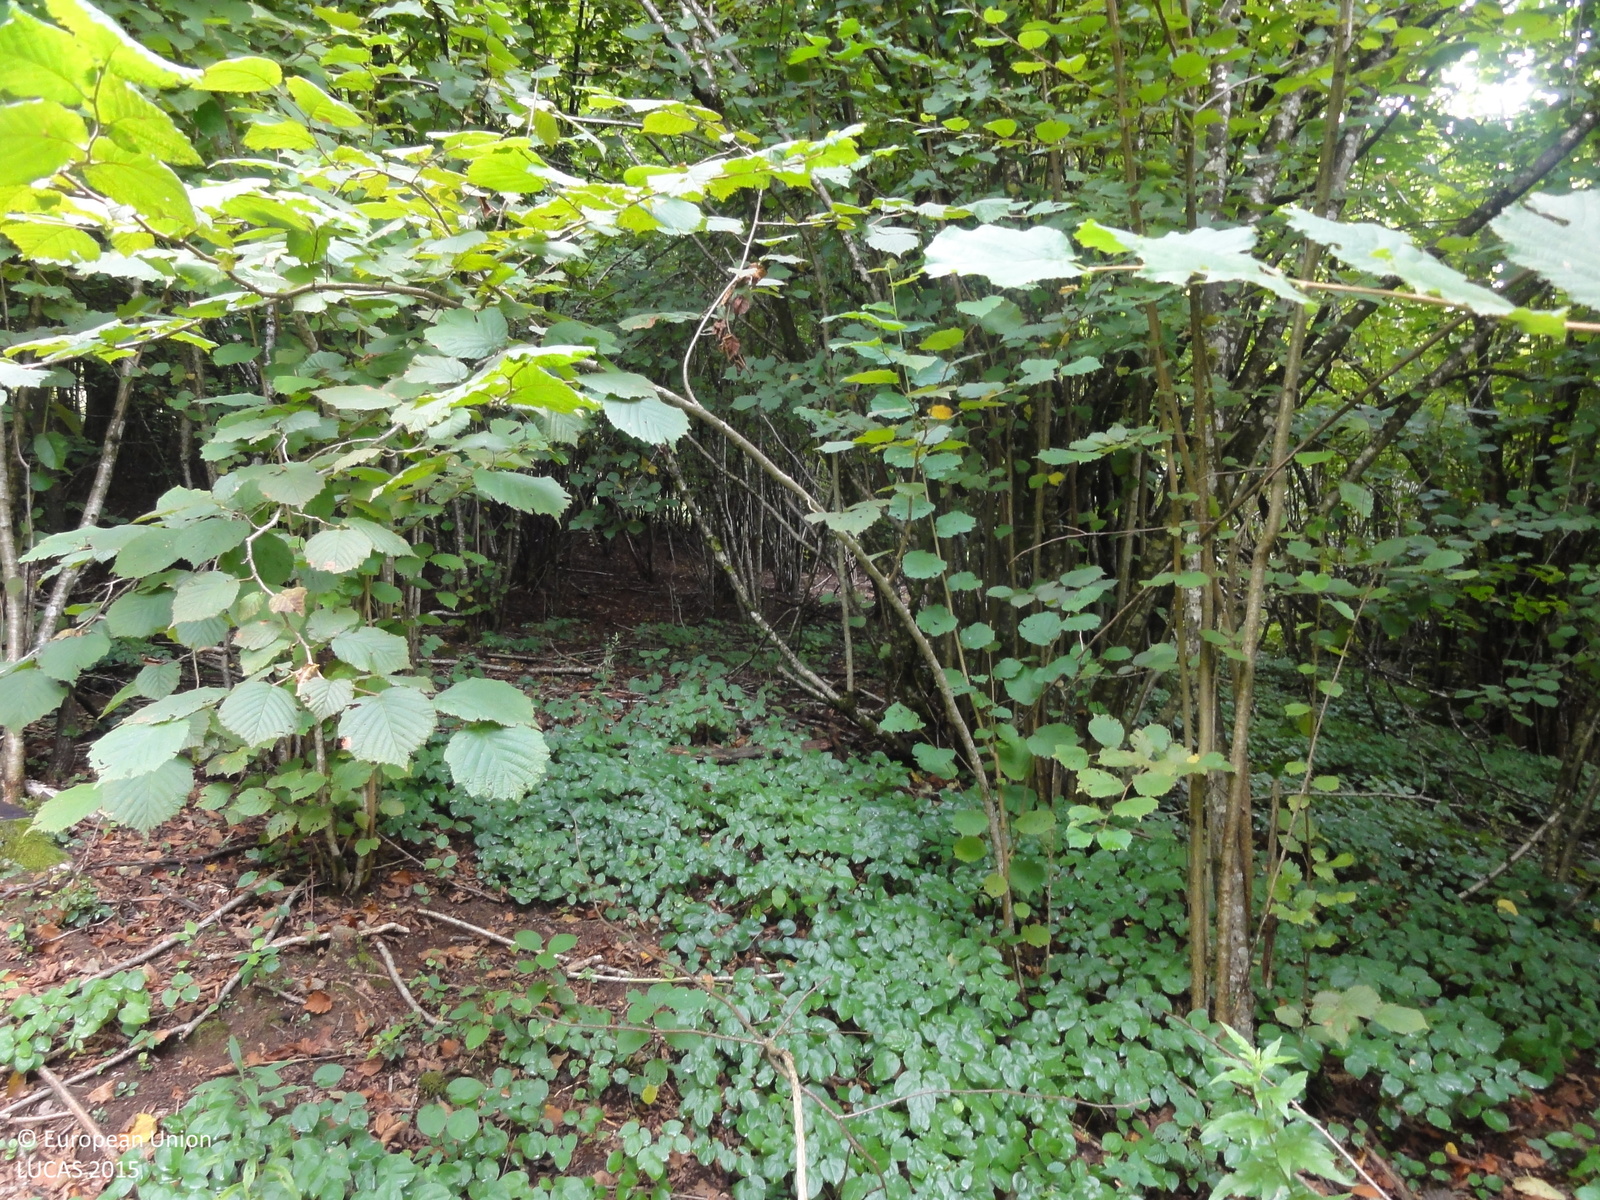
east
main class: Woodland
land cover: Broadleaved woodland
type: beech forest
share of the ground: 25 - 50 %
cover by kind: shrubs 70 %, broadleaved forest trees 30 %
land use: Forestry
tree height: > 5 m
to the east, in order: Broadleaved woodland; Spruce dominated mixed woodland; Tracks; Spruce dominated mixed woodland; Tracks; Spruce dominated mixed woodland
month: August
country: SI
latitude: 45.7448
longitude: 15.0477
